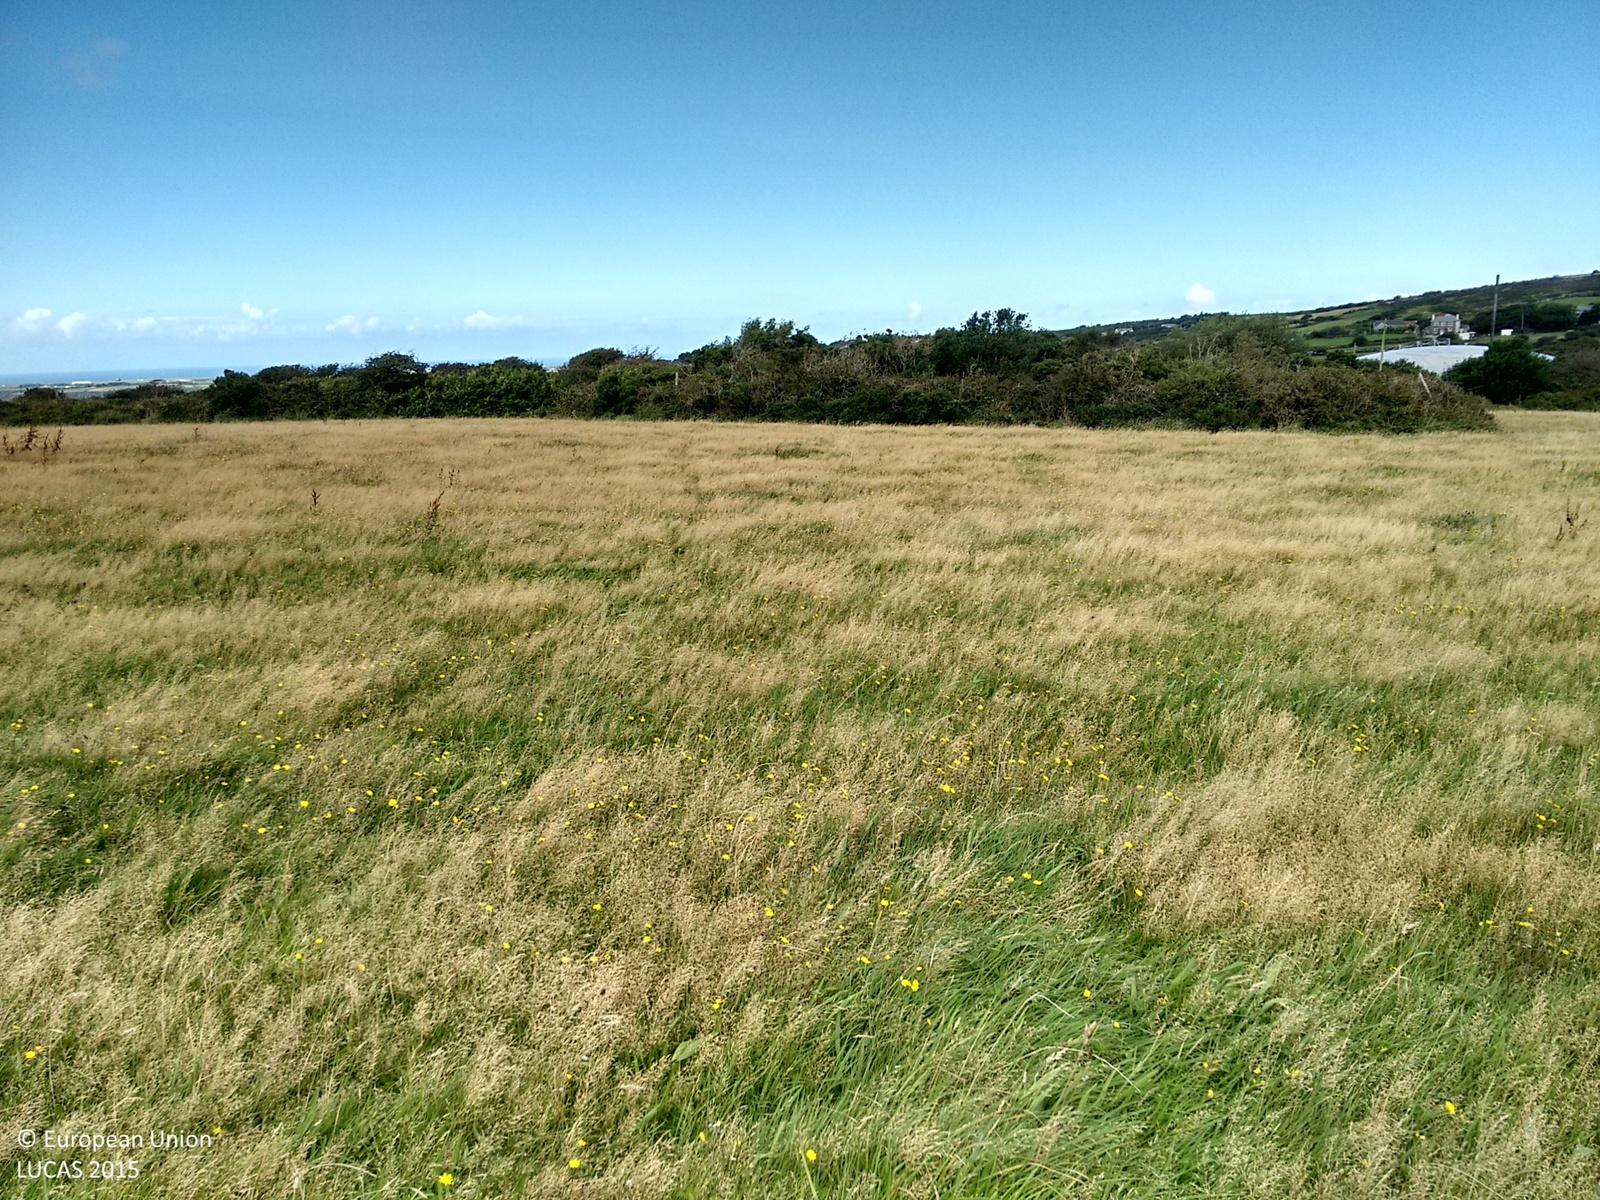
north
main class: Grassland
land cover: Grassland without tree/shrub cover
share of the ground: > 75 %
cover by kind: herbaceous plants 100 %
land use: Agriculture (excluding fallow land and kitchen gardens)
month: August
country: GB
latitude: 50.2169
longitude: -5.2142
